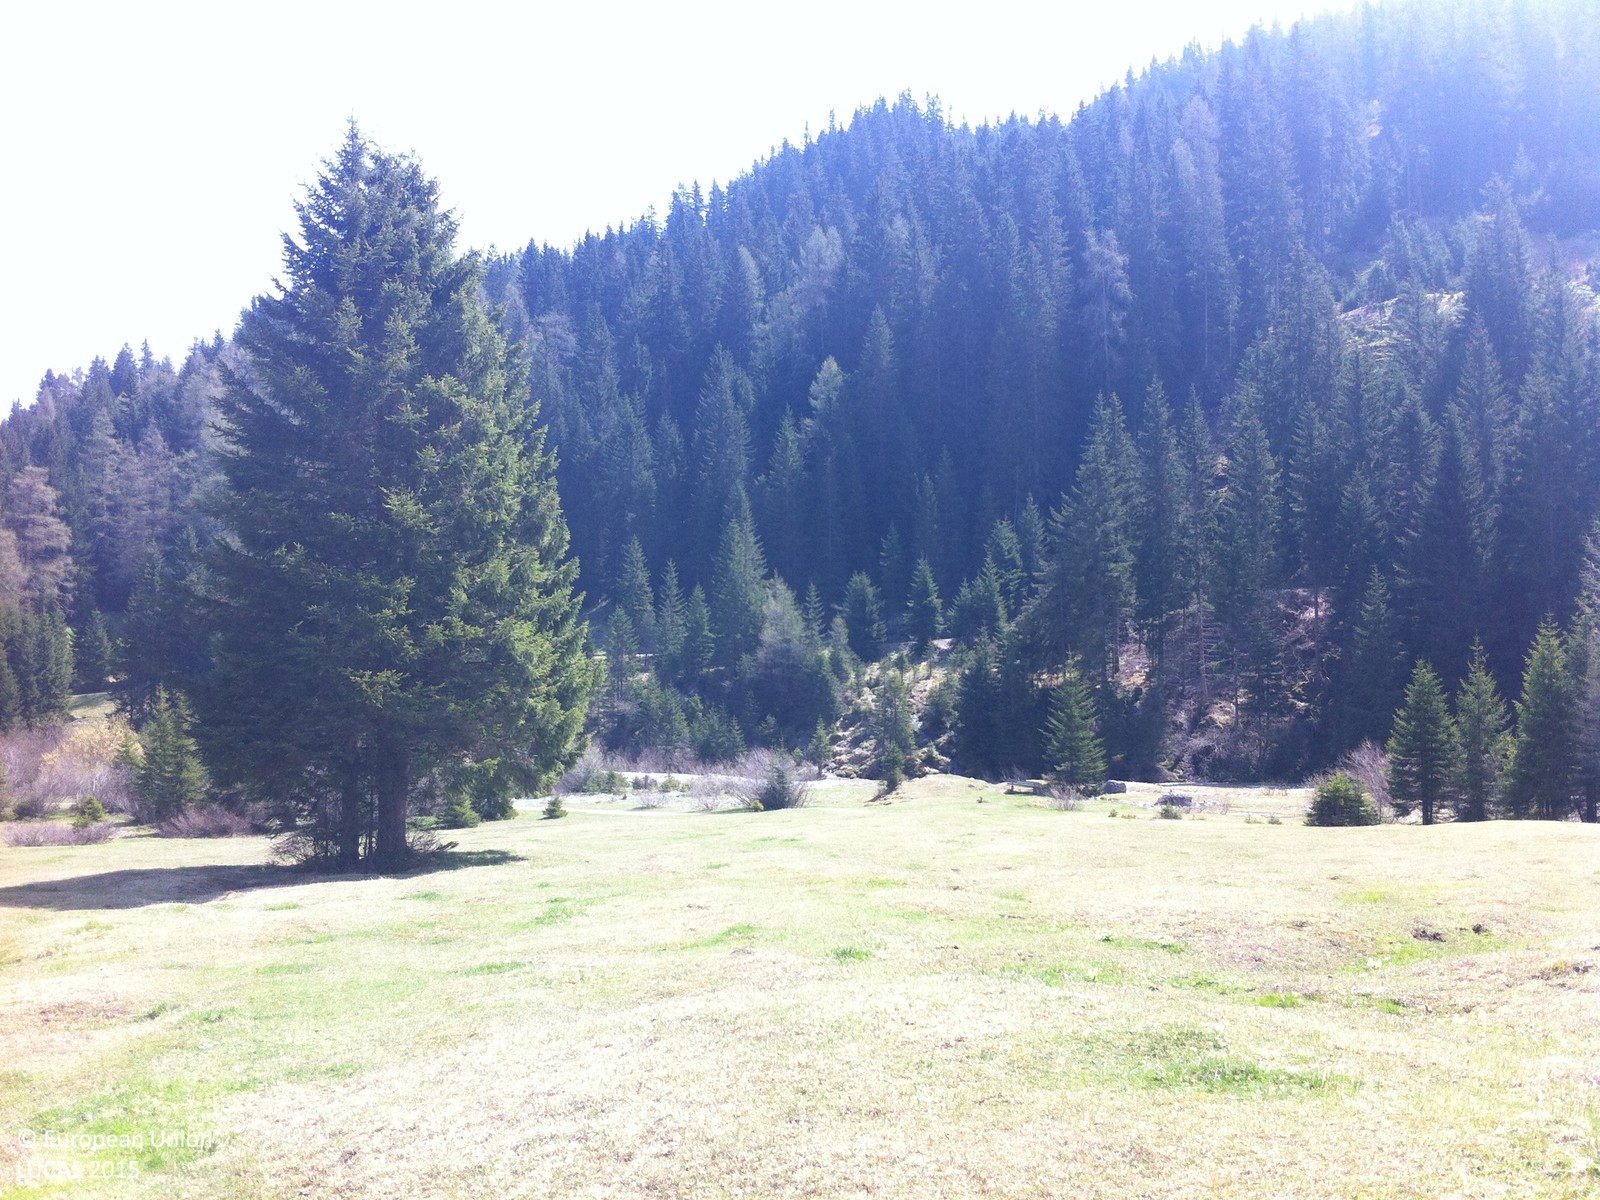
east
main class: Grassland
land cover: Grassland without tree/shrub cover
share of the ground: > 75 %
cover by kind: herbaceous plants 100 %
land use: Agriculture (excluding fallow land and kitchen gardens)
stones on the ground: < 10 %
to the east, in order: Grassland without tree/shrub cover; Tracks; Shrubland with sparse tree cover; Artificial constructions; Inland fresh running water; Spruce dominated coniferous woodland; Grass margins; Tracks; Ditches and canals; Grassland with sparse tree/shrub cover; Spruce dominated coniferous woodland
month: May
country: AT
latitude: 47.0084
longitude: 11.4060
